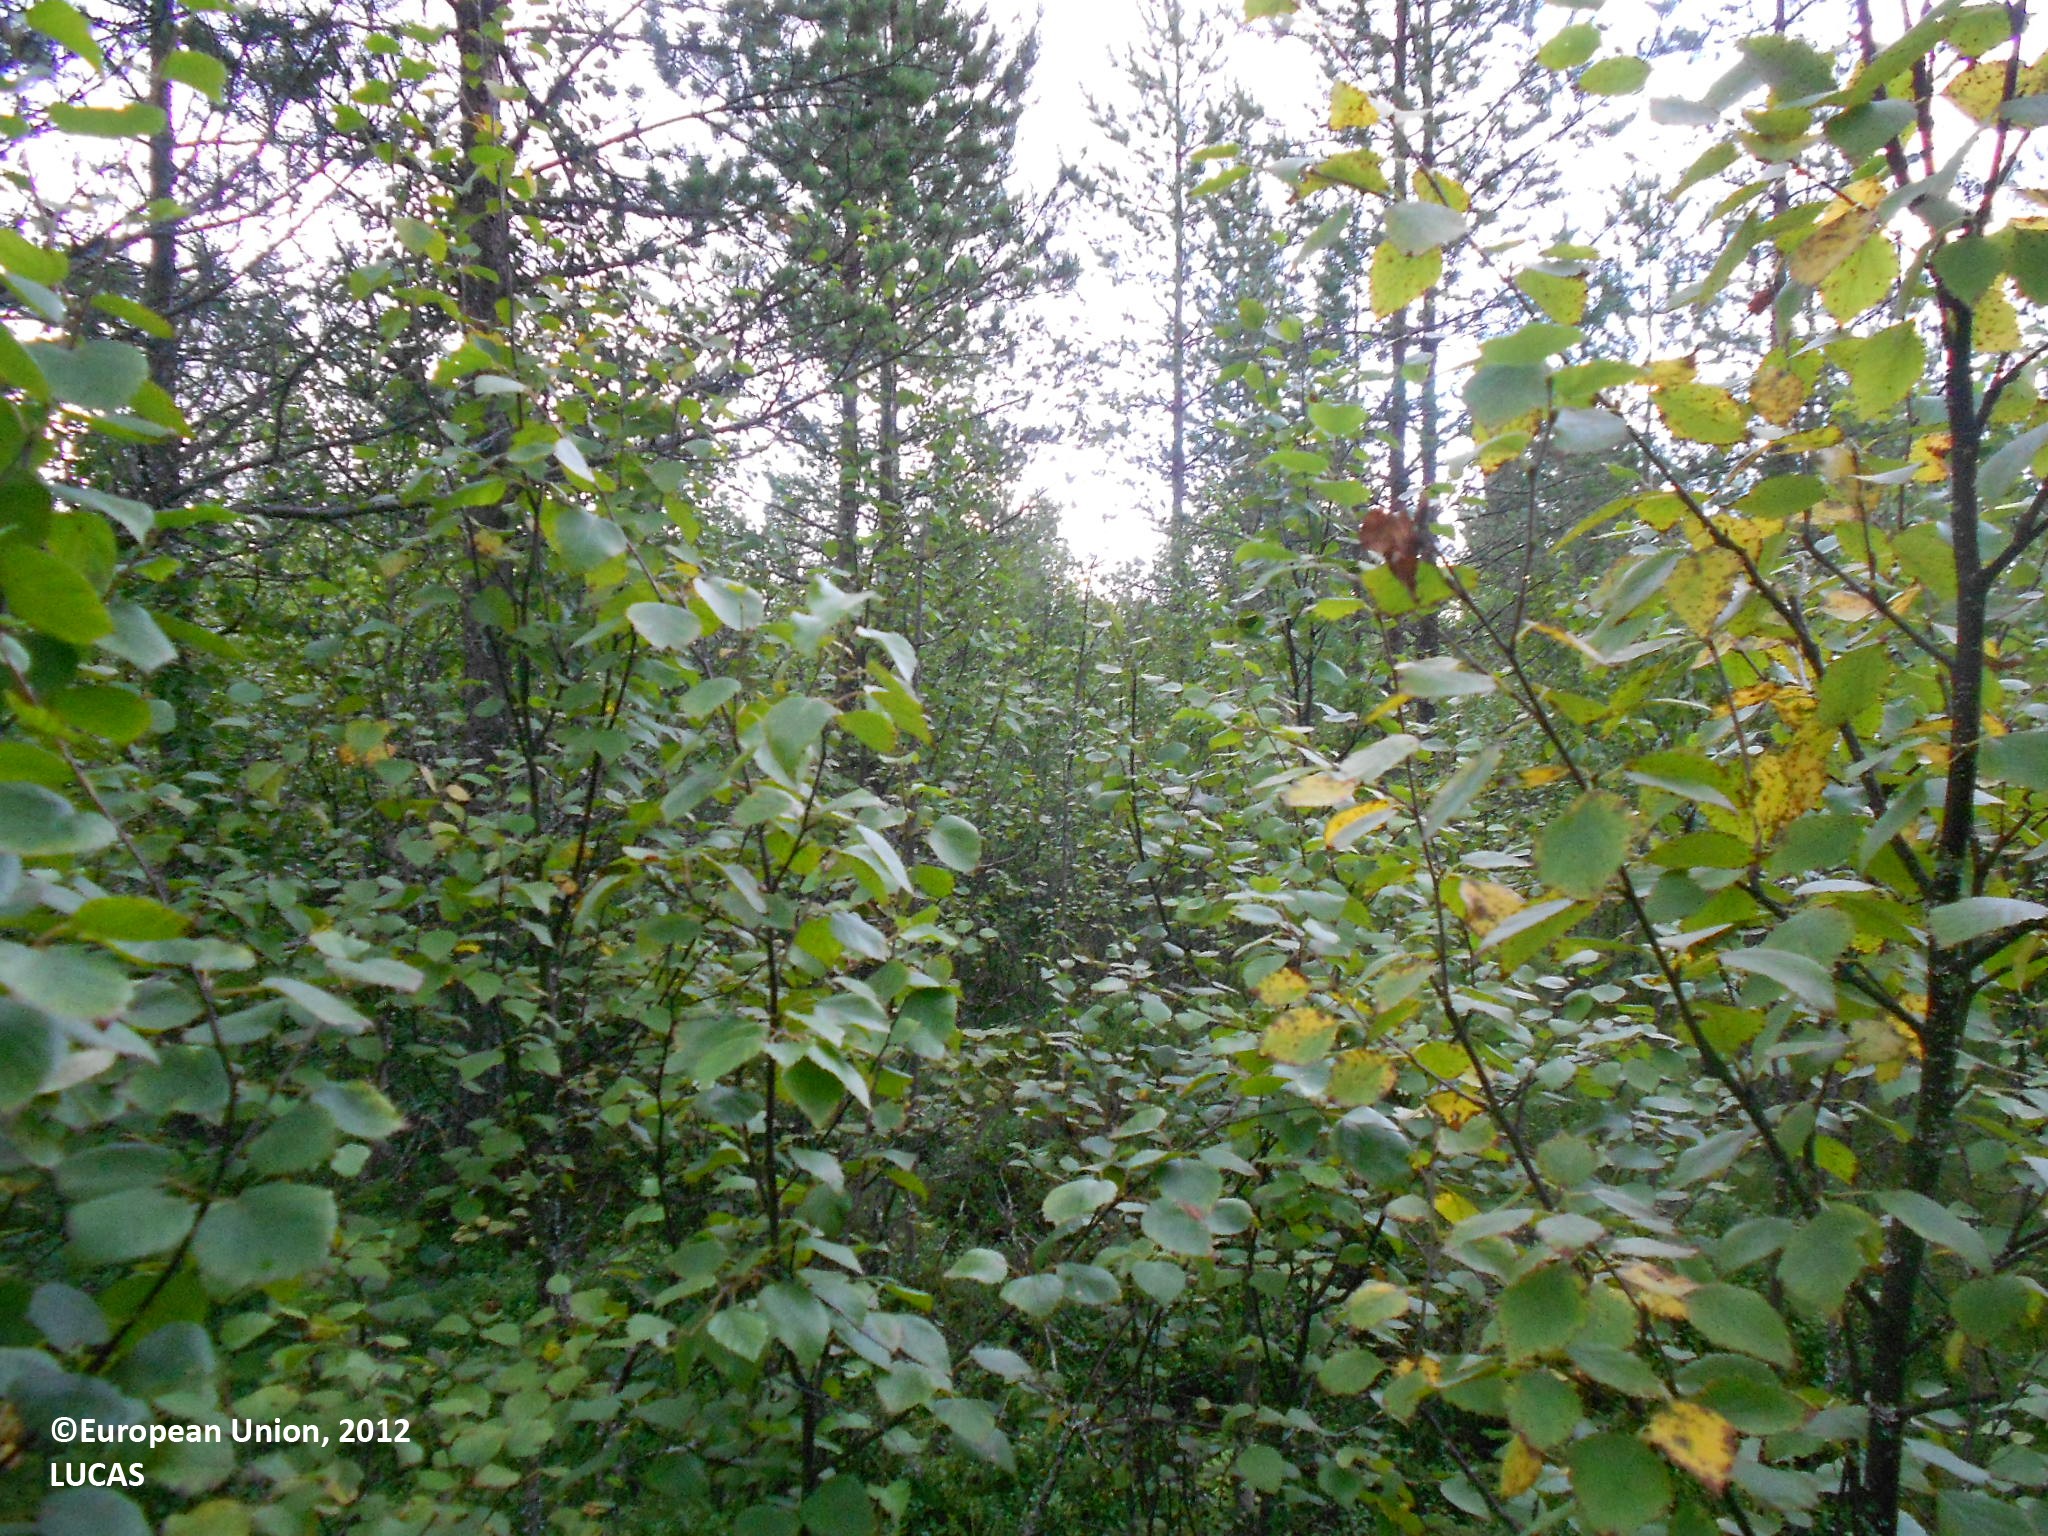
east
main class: Woodland
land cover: Pine dominated mixed woodland
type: boreal forest
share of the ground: > 75 %
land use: Forestry
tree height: > 5 m
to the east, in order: Pine dominated mixed woodland; Ditches and canals; Pine dominated mixed woodland; Spruce dominated mixed woodland; Ditches and canals; Spruce dominated mixed woodland; Ditches and canals; Spruce dominated coniferous woodland; Inland marshes; Pine dominated coniferous woodland
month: August
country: FI
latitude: 63.8230
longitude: 28.4488
